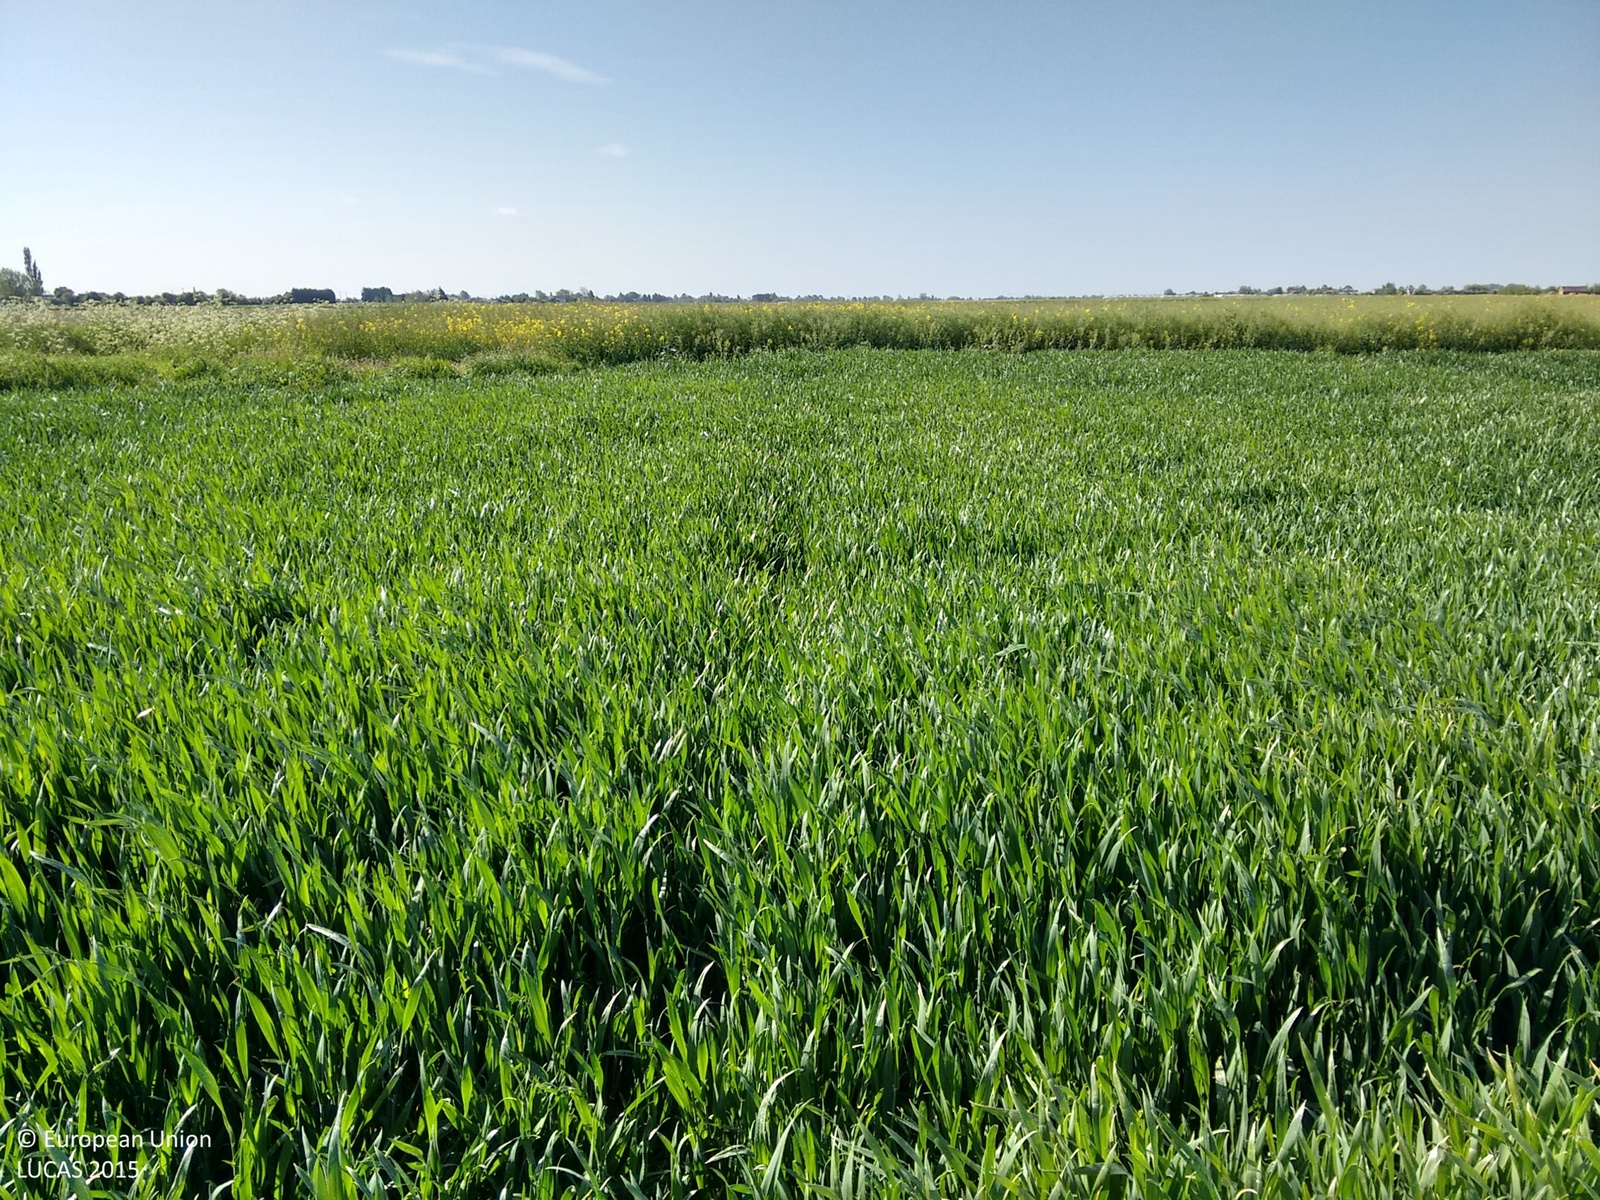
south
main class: Cropland
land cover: Common wheat
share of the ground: > 75 %
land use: Agriculture (excluding fallow land and kitchen gardens)
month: May
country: GB
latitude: 52.7971
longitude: -0.1037
